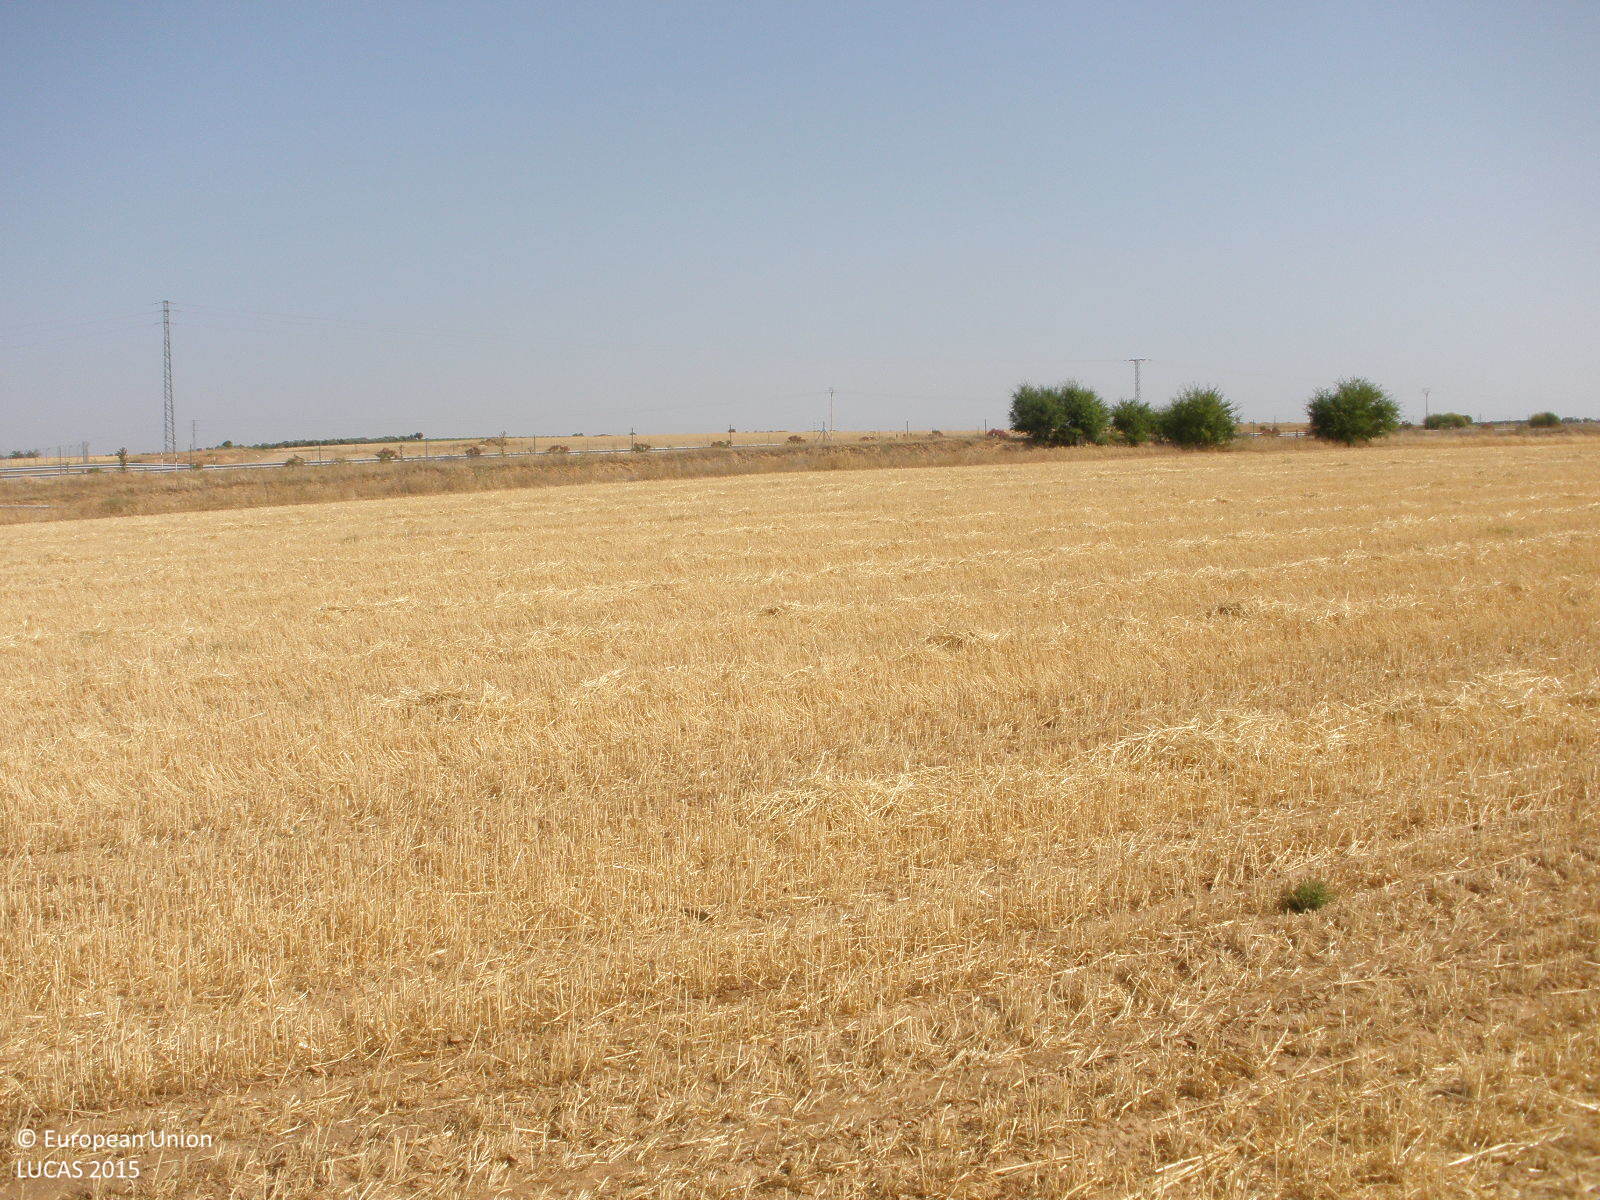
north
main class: Cropland
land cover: Common wheat
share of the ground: < 10 %
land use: Agriculture (excluding fallow land and kitchen gardens)
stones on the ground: < 10 %
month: July
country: ES
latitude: 39.9514
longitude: -3.2406
